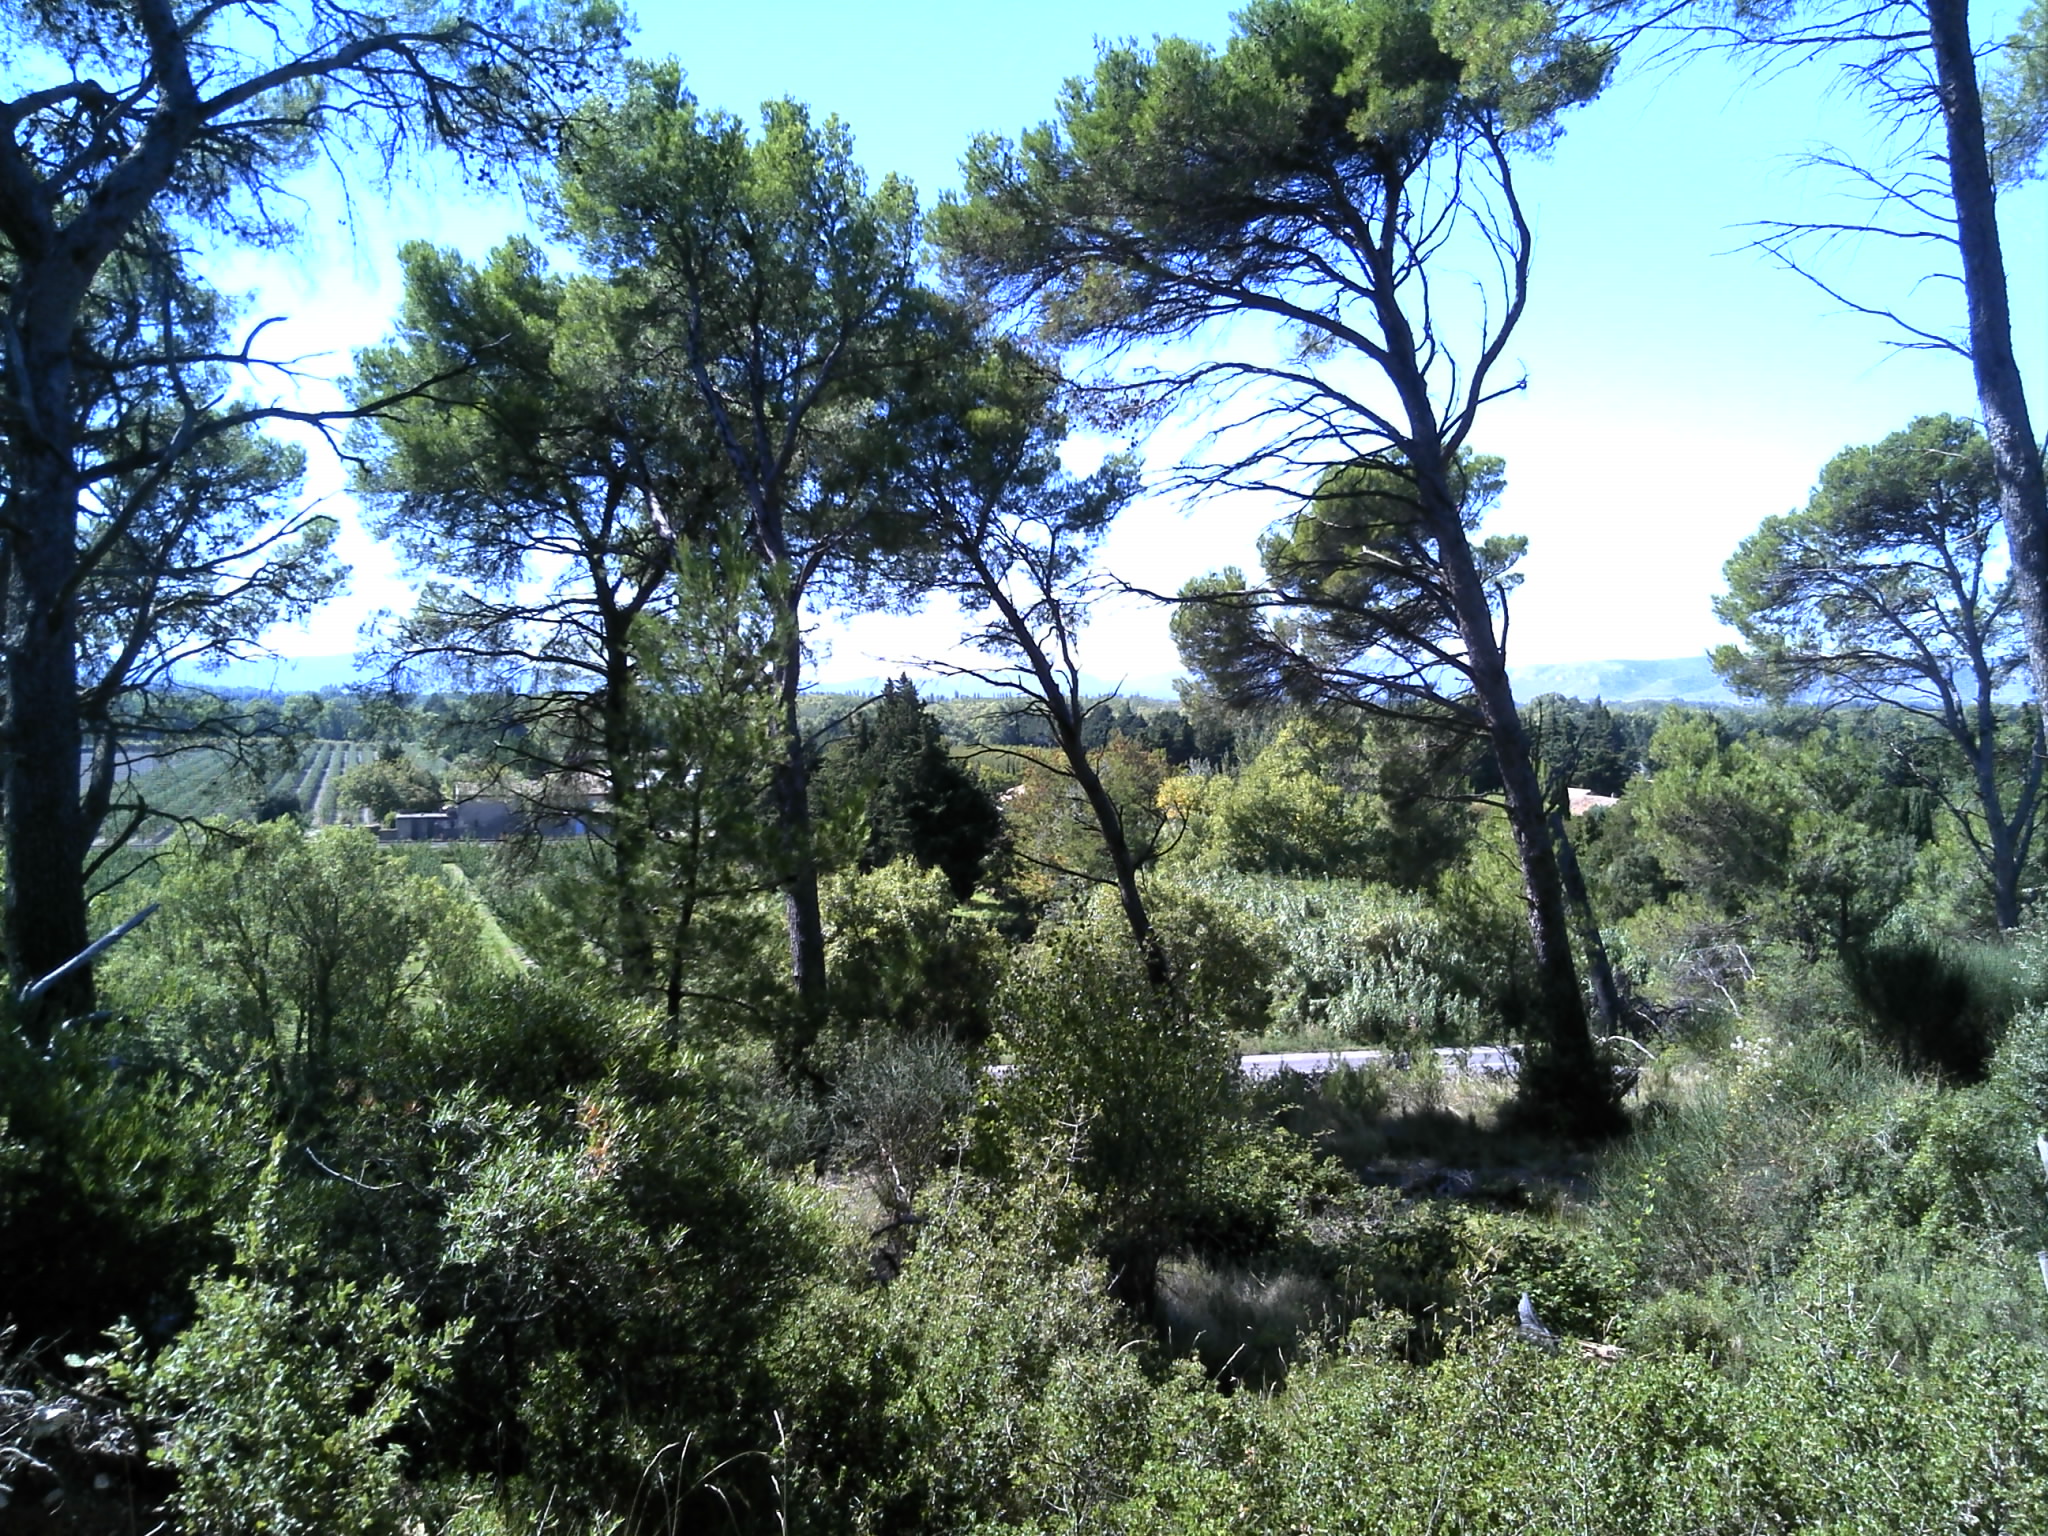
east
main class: Woodland
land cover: Pine dominated coniferous woodland
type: coniferous forest of the mediterranean region
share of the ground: 50 - 75 %
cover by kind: coniferous forest trees 50 %, shrubs 30 %, herbaceous plants 20 %
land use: Forestry
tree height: > 5 m
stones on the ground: < 10 %
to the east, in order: Pine dominated coniferous woodland; Tracks; Pine dominated coniferous woodland
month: September
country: FR
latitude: 43.7663
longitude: 5.1272
